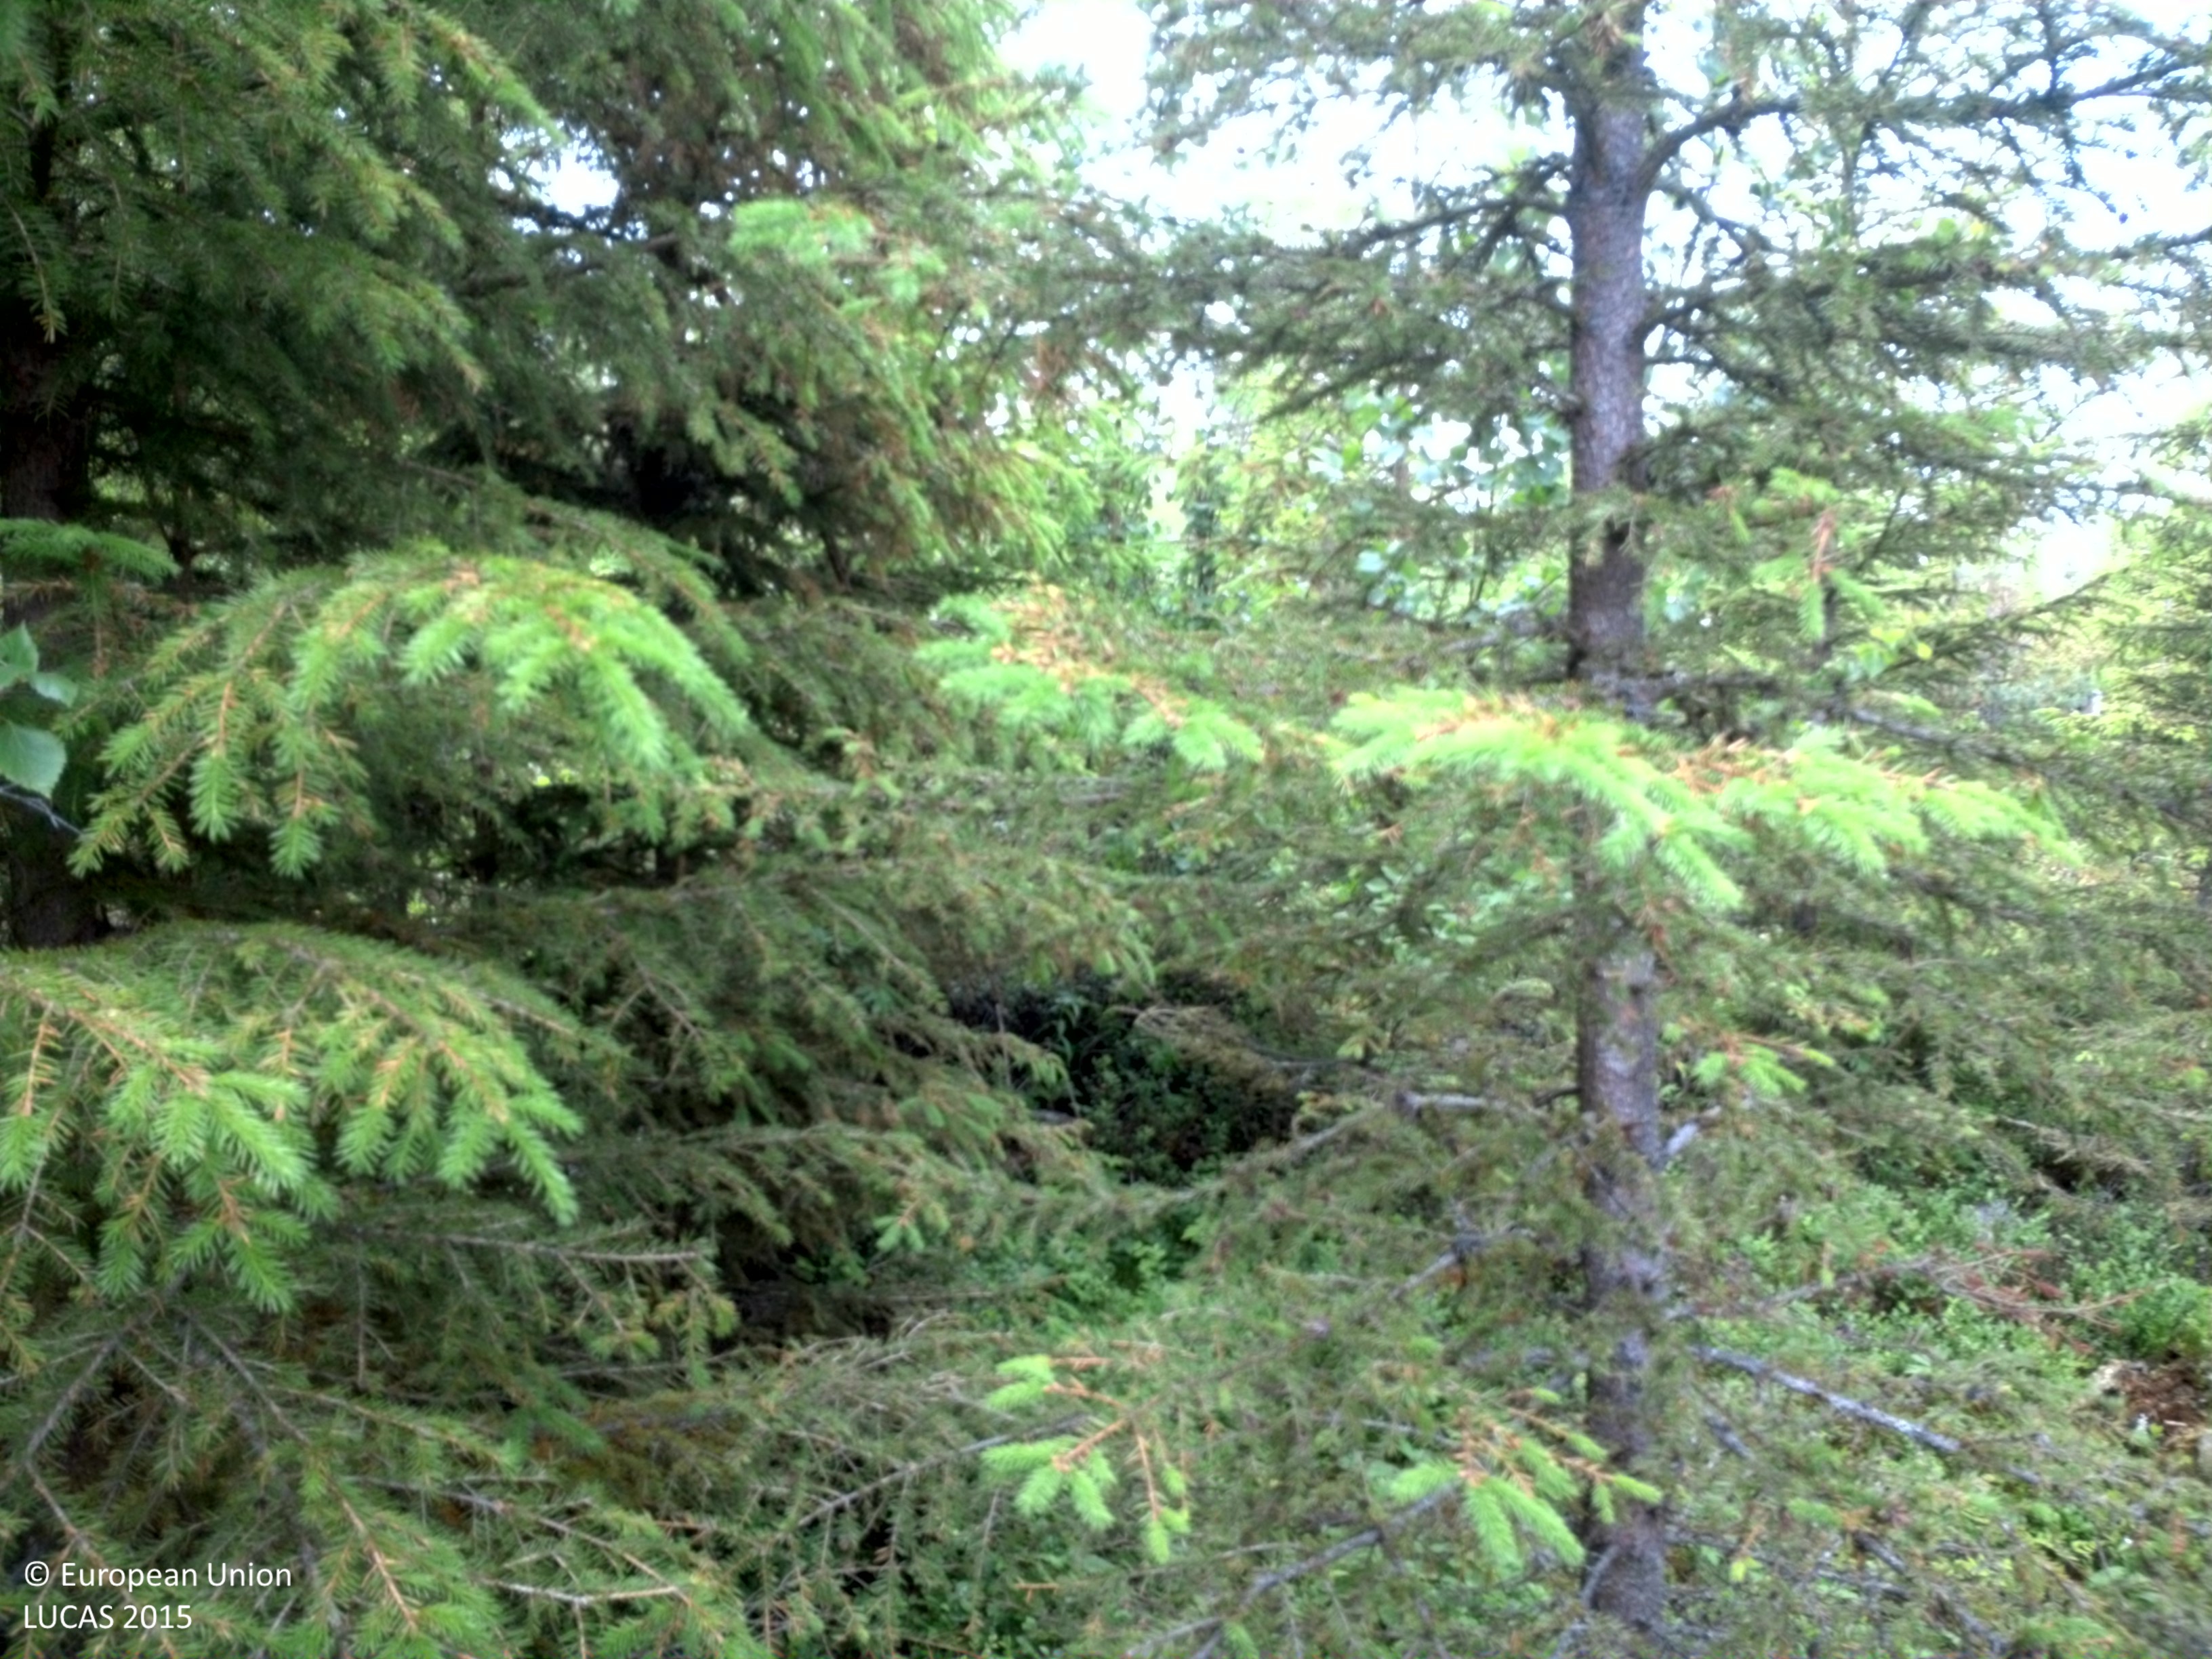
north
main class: Woodland
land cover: Spruce dominated mixed woodland
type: boreal forest
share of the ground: 50 - 75 %
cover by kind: coniferous forest trees 45 %, shrubs 20 %, herbaceous plants 20 %, broadleaved forest trees 15 %
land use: Forestry
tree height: > 5 m
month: July
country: SE
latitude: 64.7152
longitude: 18.5070
